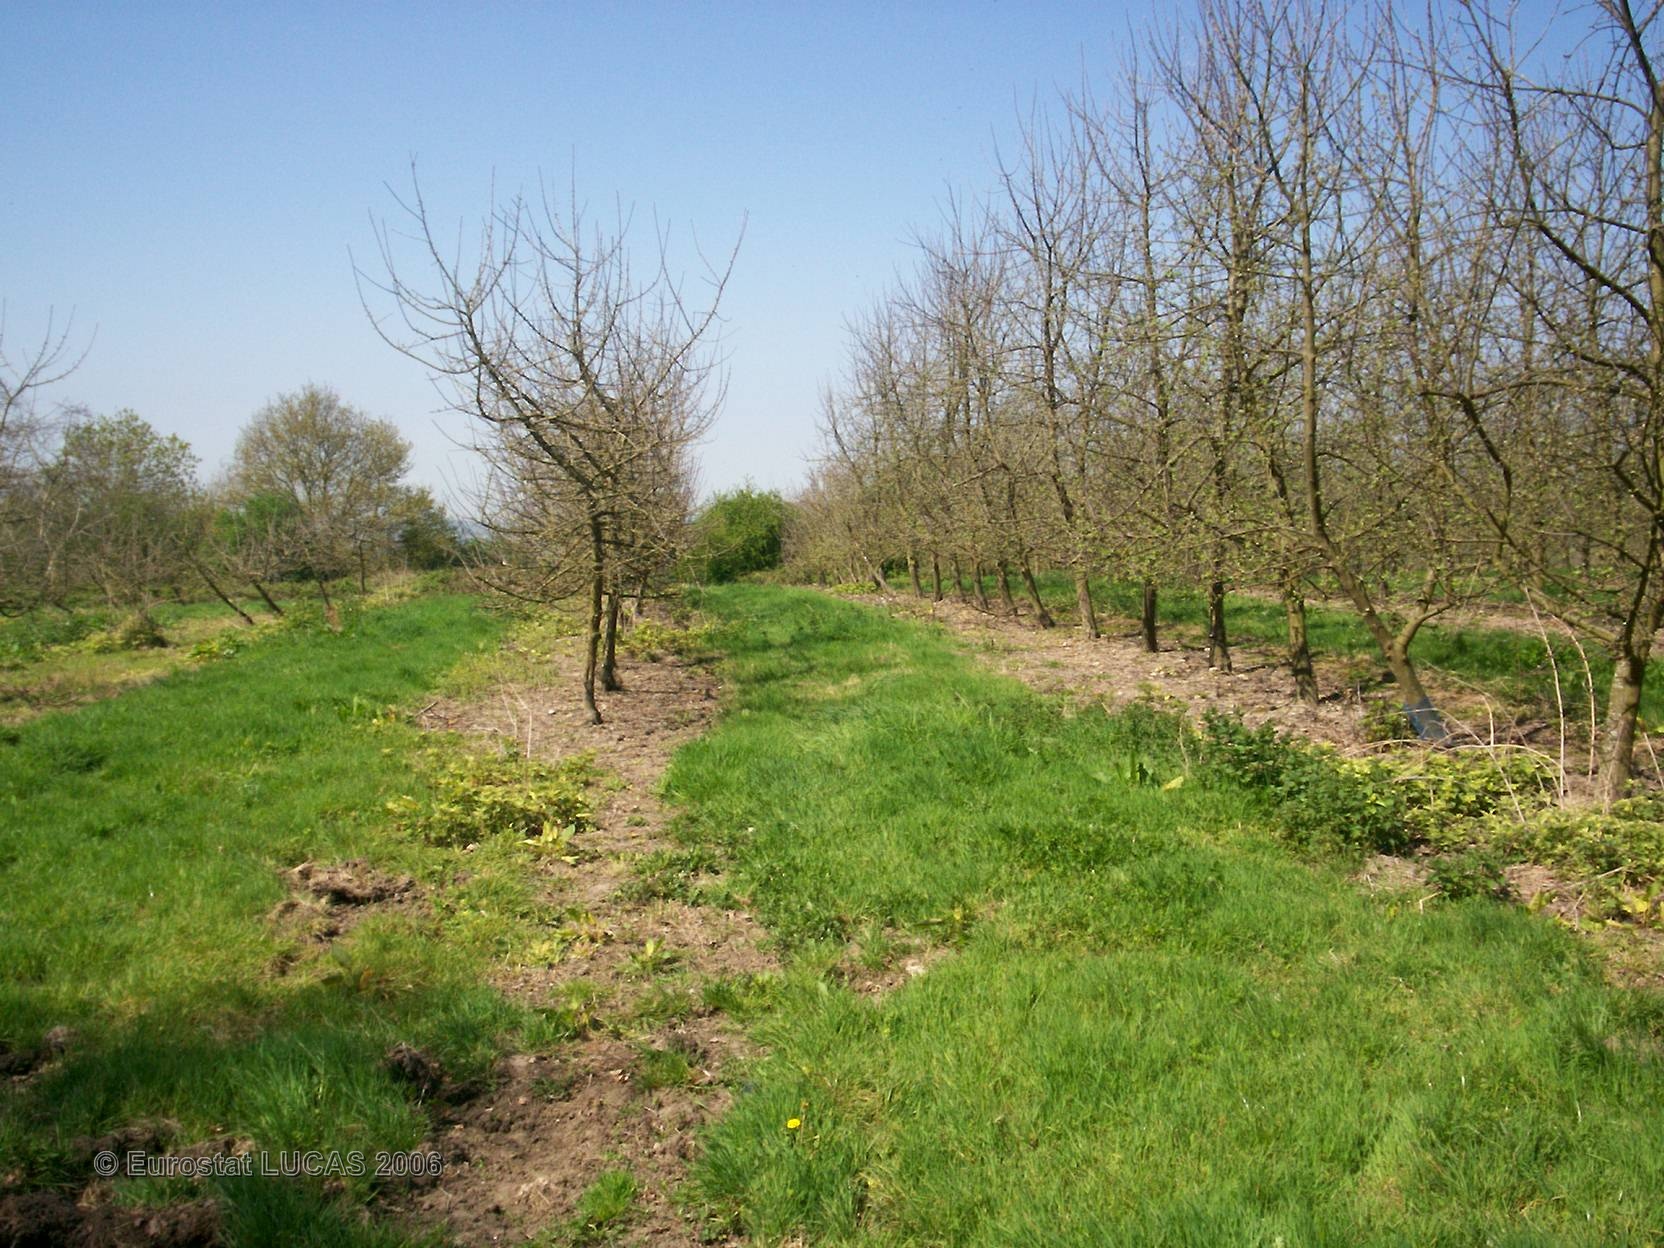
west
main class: Grassland
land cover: Grassland without tree/shrub cover
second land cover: Grassland with sparse tree/shrub cover
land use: Road transport
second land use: Agriculture (excluding fallow land and kitchen gardens)
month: April
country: FR
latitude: 49.2500
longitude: -0.0466
